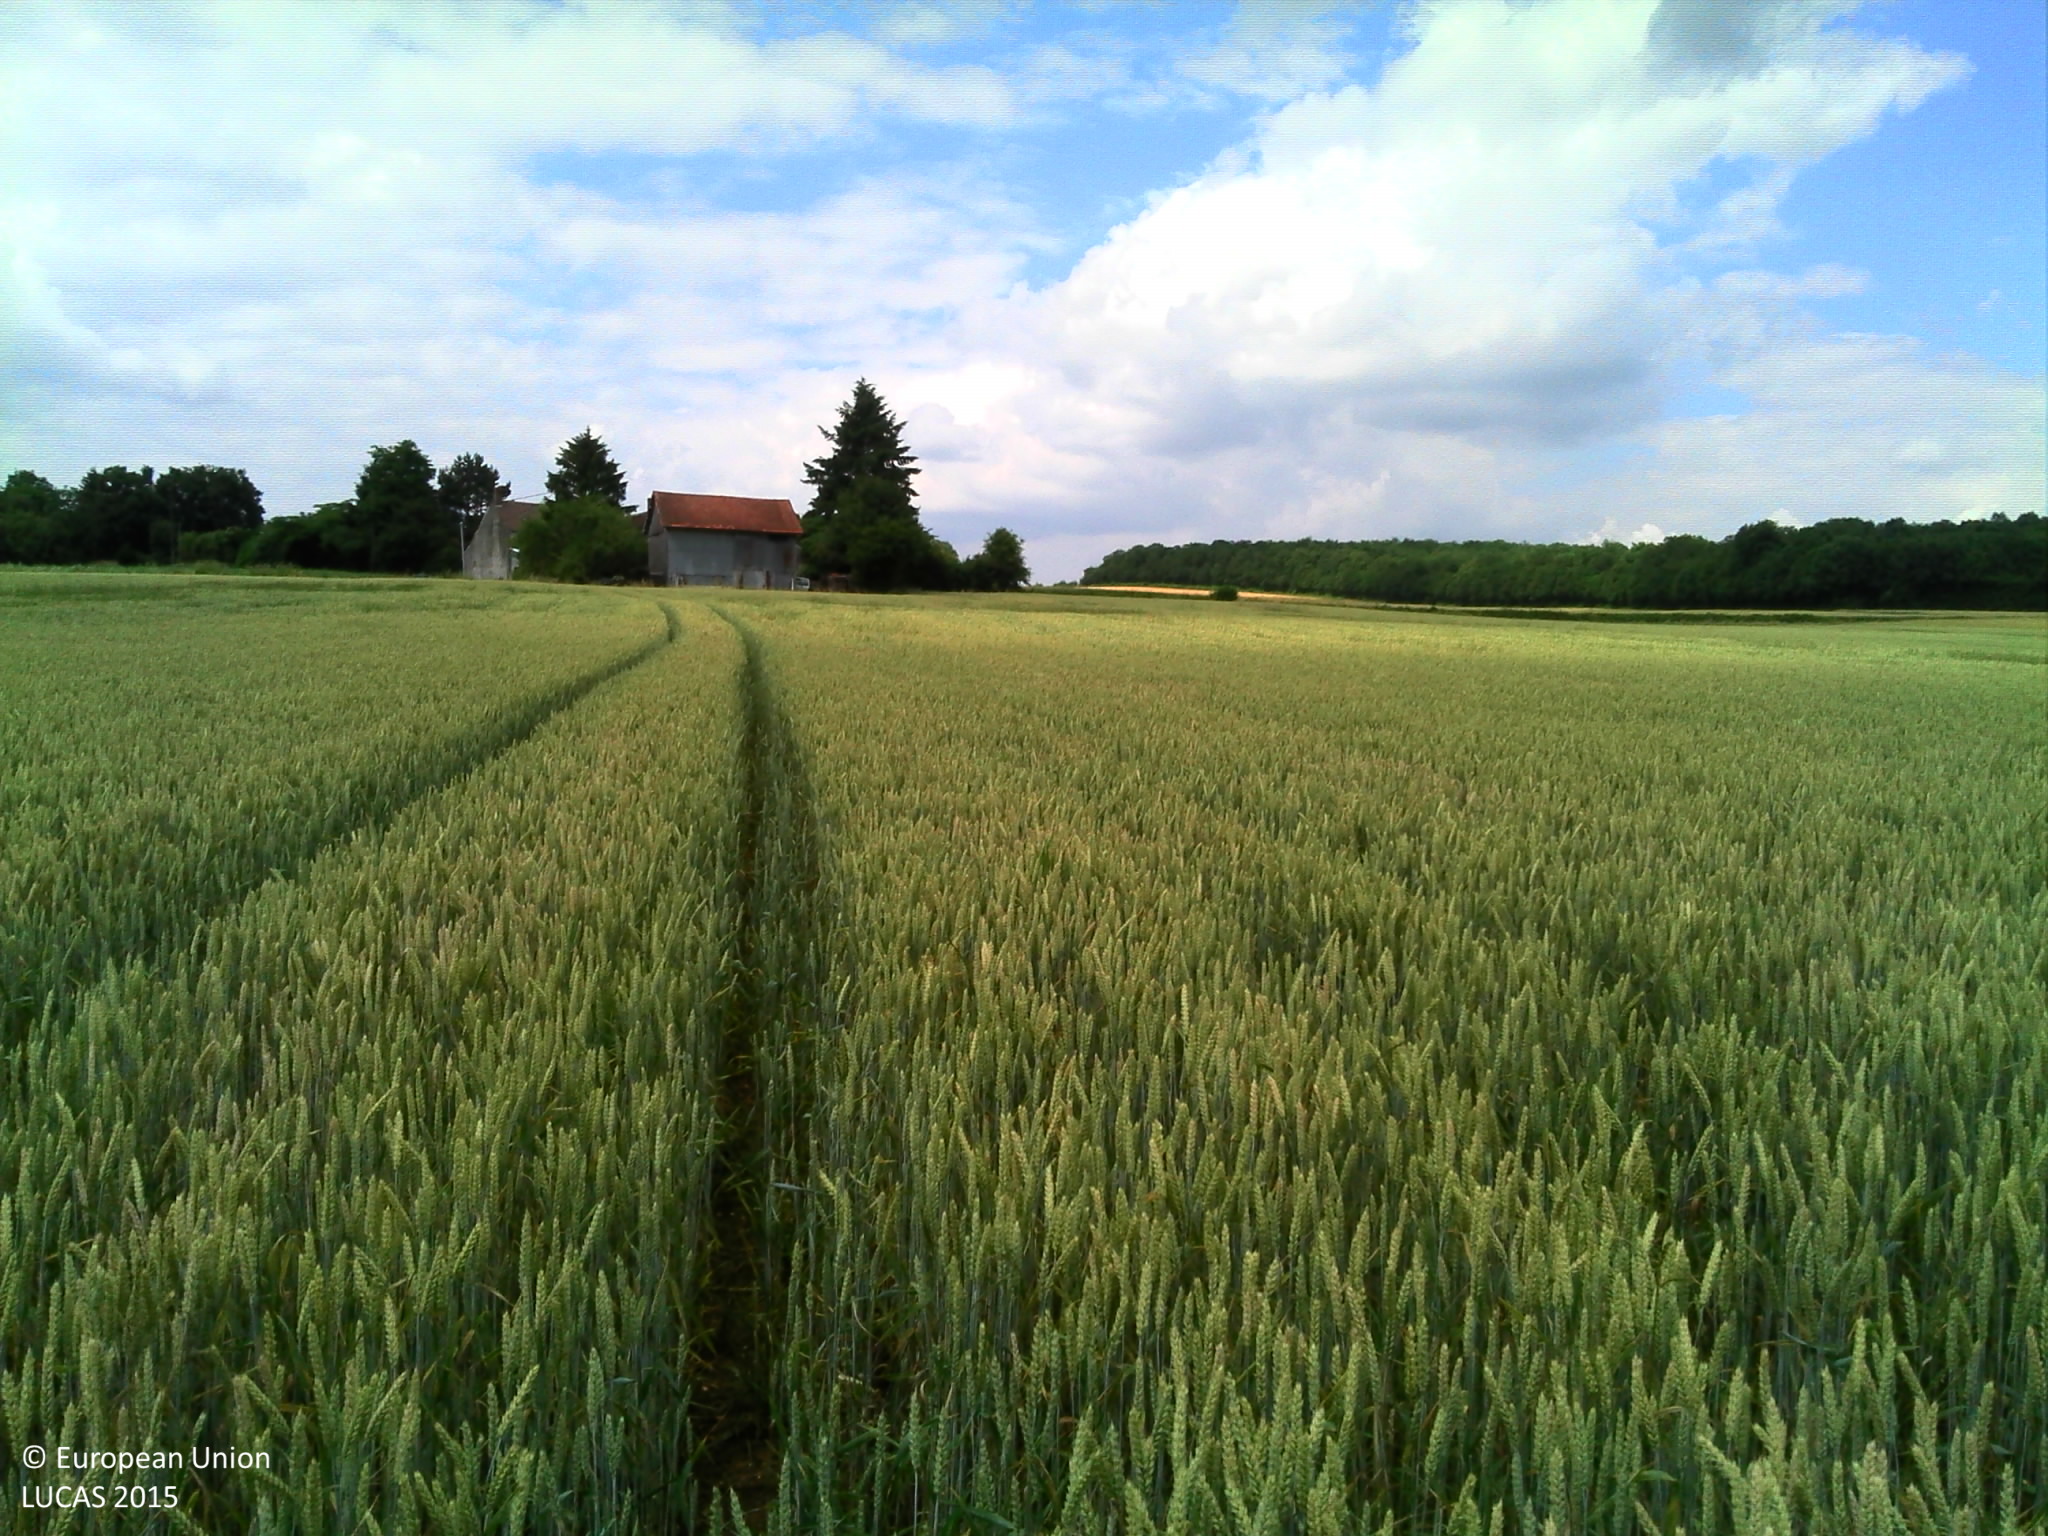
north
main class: Cropland
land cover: Common wheat
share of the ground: > 75 %
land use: Agriculture (excluding fallow land and kitchen gardens)
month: June
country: FR
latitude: 47.4481
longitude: 3.1118
